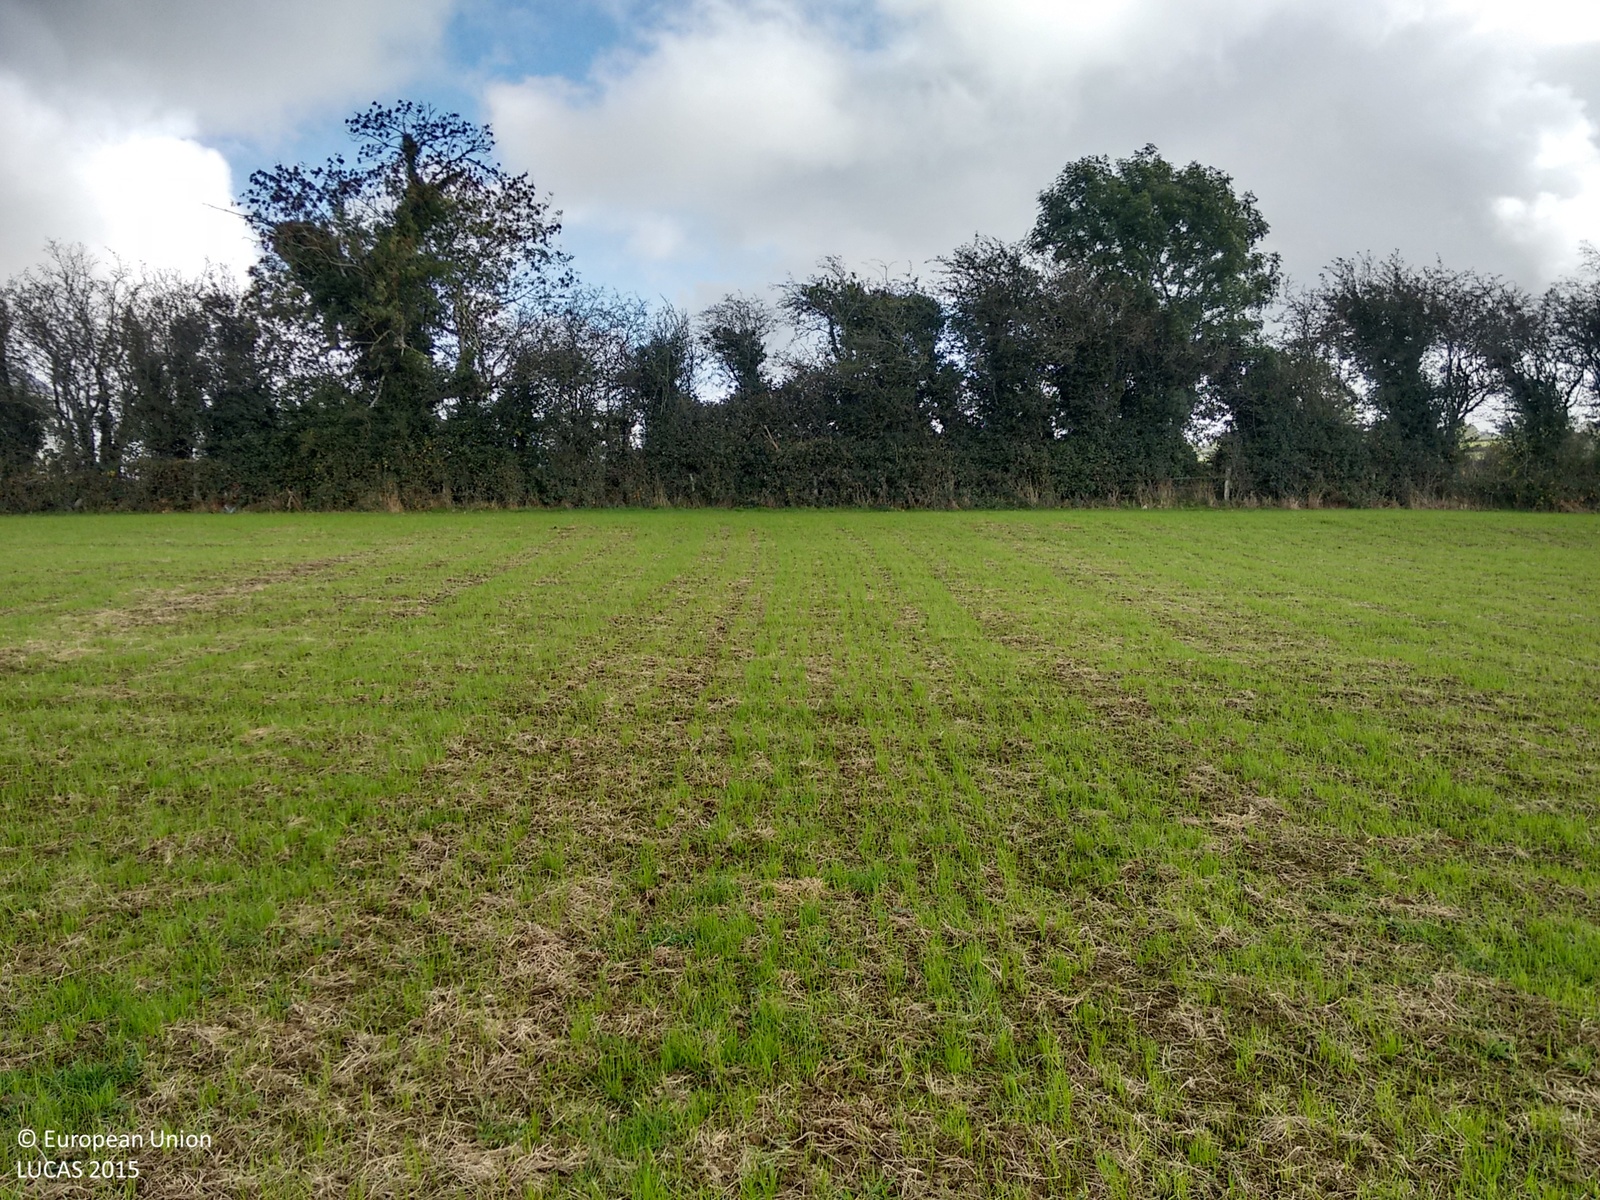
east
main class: Grassland
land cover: Grassland without tree/shrub cover
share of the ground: > 75 %
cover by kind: herbaceous plants 85 %, unconsolidated bare surface 10 %
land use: Agriculture (excluding fallow land and kitchen gardens)
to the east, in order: Grassland without tree/shrub cover; Fences; Broadleaved woodland; Grassland without tree/shrub cover; Broadleaved woodland; Fences; Grassland without tree/shrub cover; Electric lines; Grassland without tree/shrub cover
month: October
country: IE
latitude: 53.7794
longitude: -8.0690
